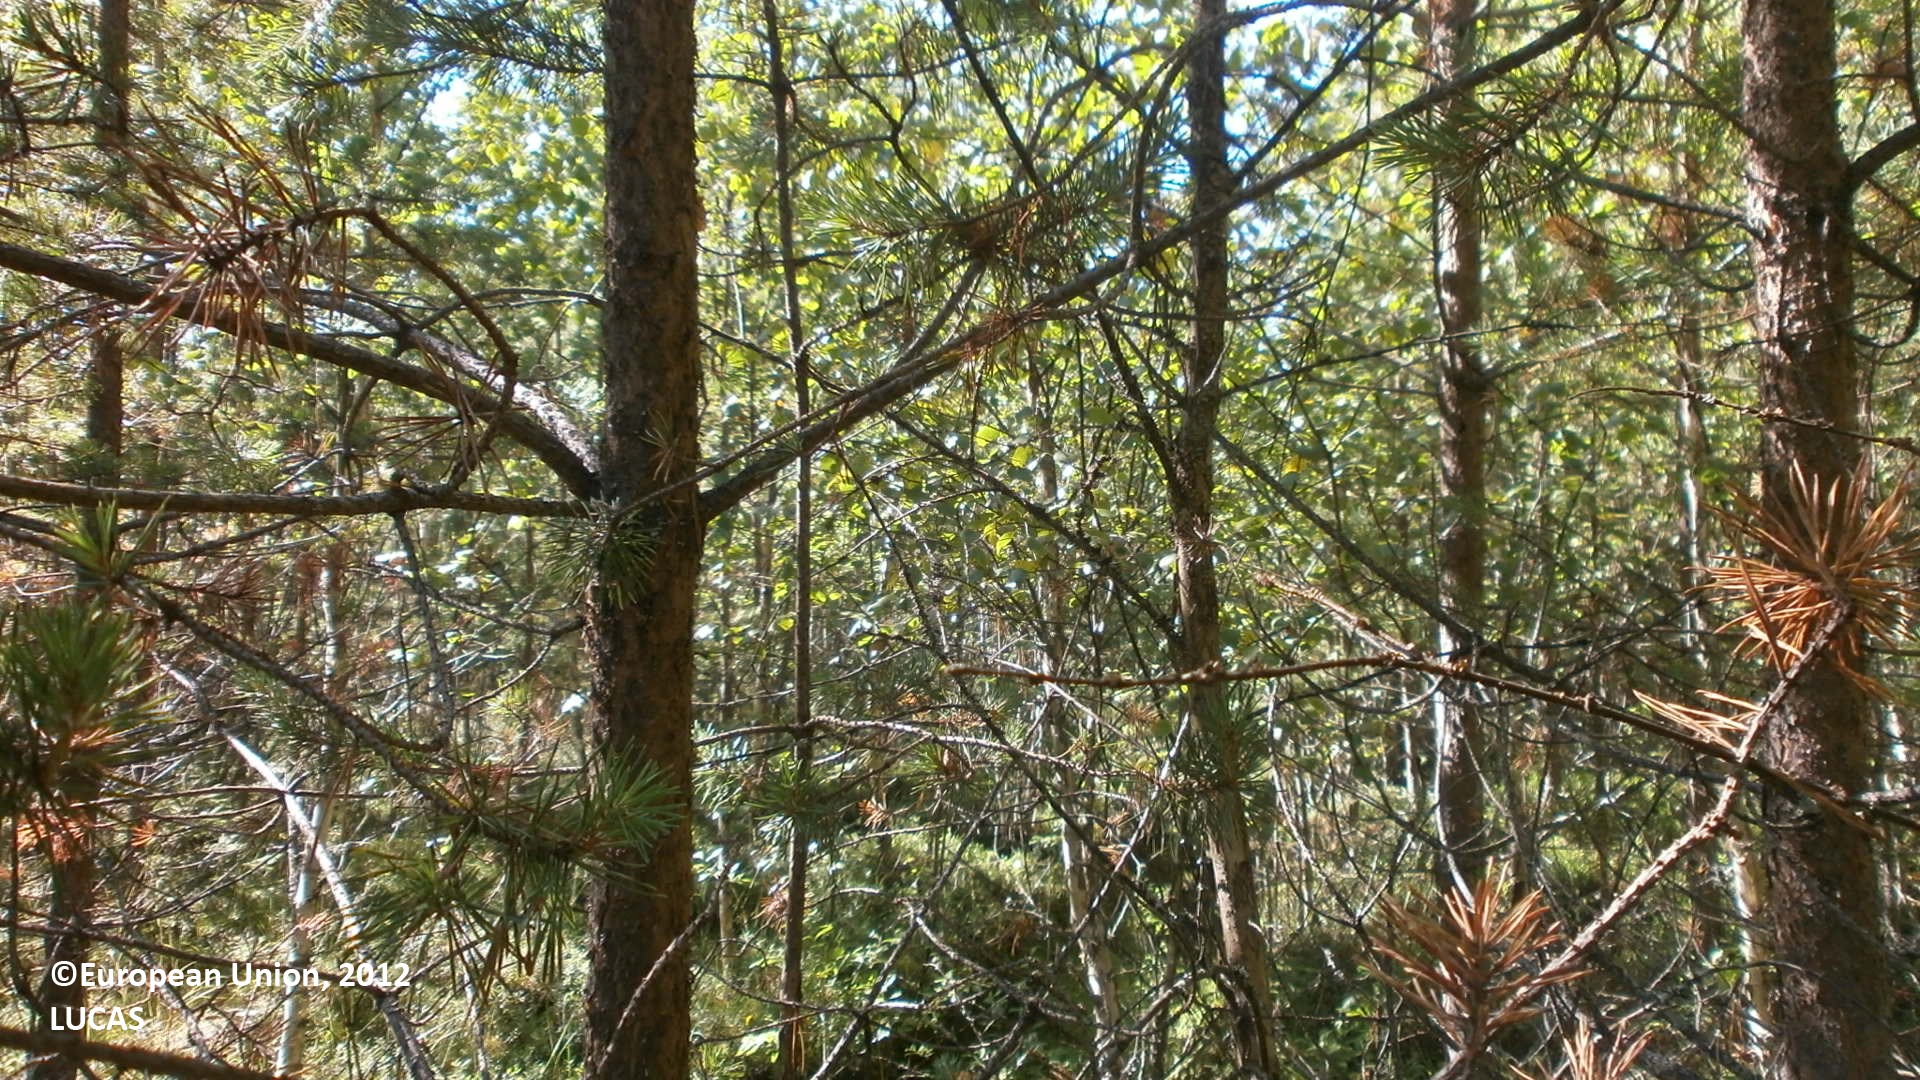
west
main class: Woodland
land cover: Pine dominated mixed woodland
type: boreal forest
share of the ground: > 75 %
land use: Forestry
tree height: > 5 m
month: July
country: FI
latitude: 64.1296
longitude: 23.9280
